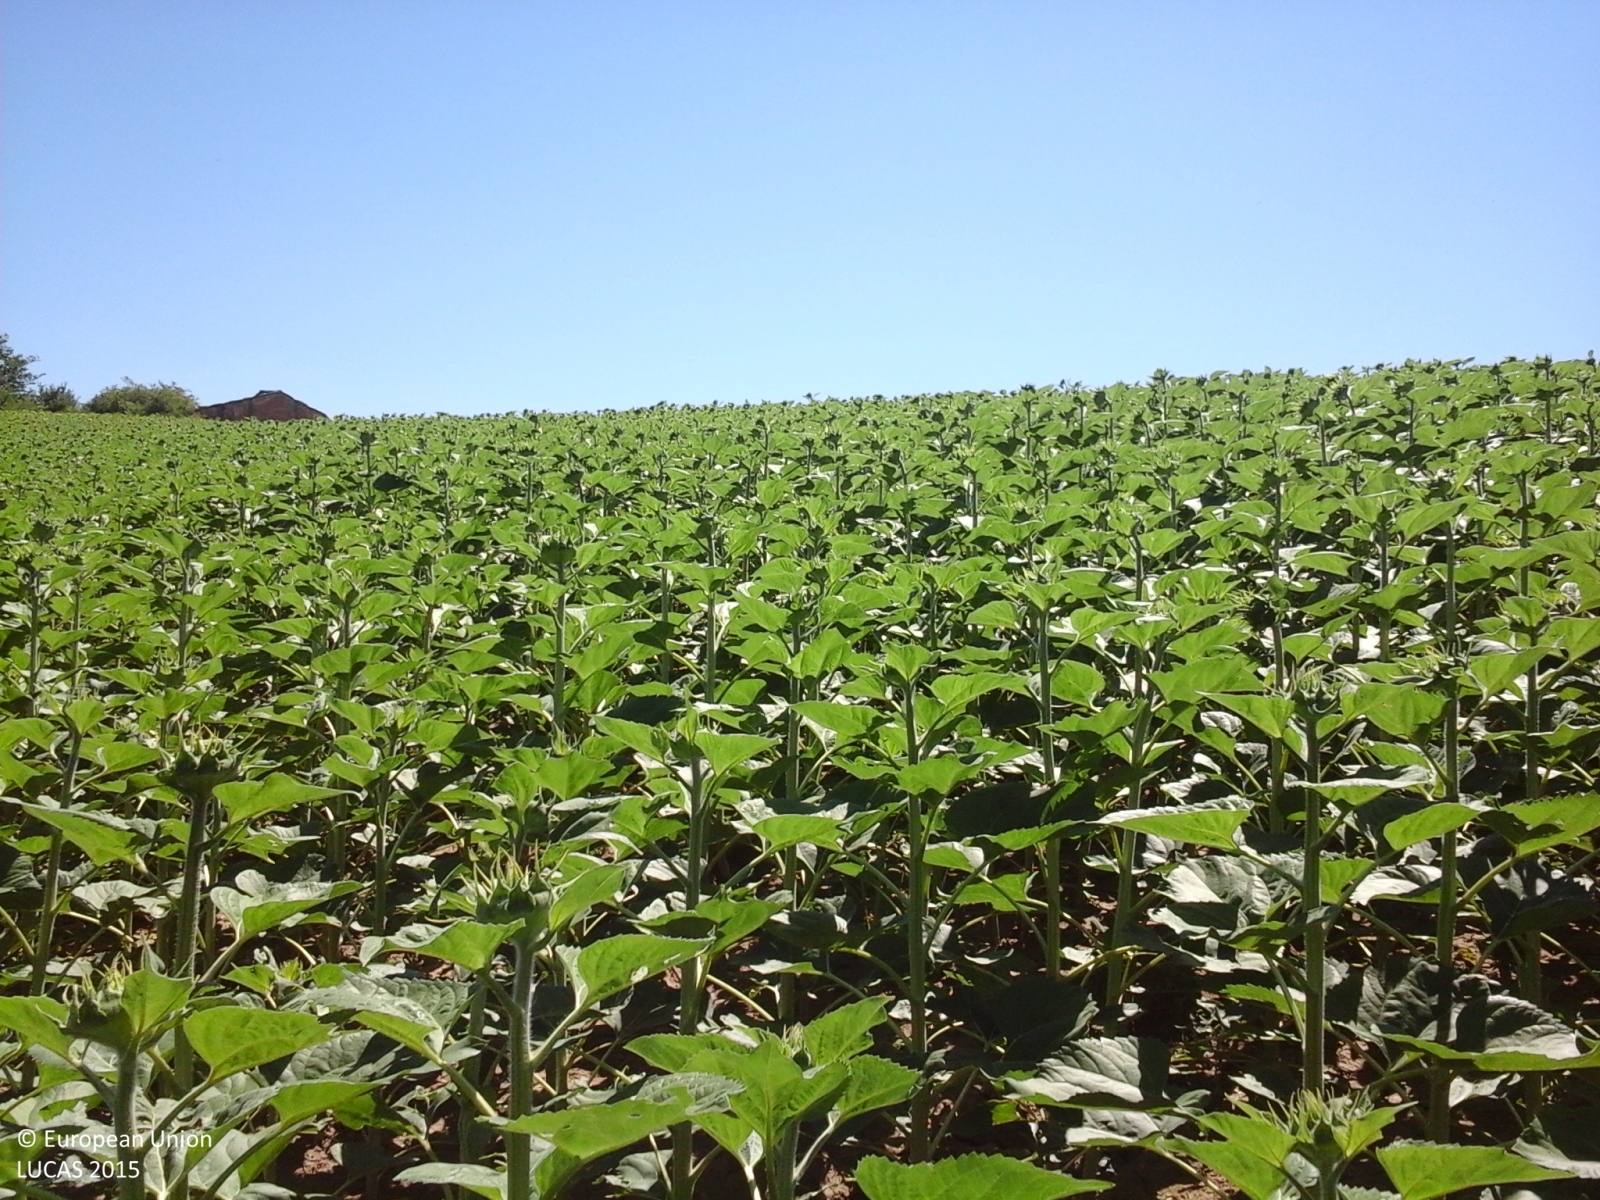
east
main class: Cropland
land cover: Sunflower
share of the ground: > 75 %
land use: Agriculture (excluding fallow land and kitchen gardens)
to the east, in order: Sunflower; Tracks; Sunflower
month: June
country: IT
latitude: 43.4105
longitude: 13.3875
